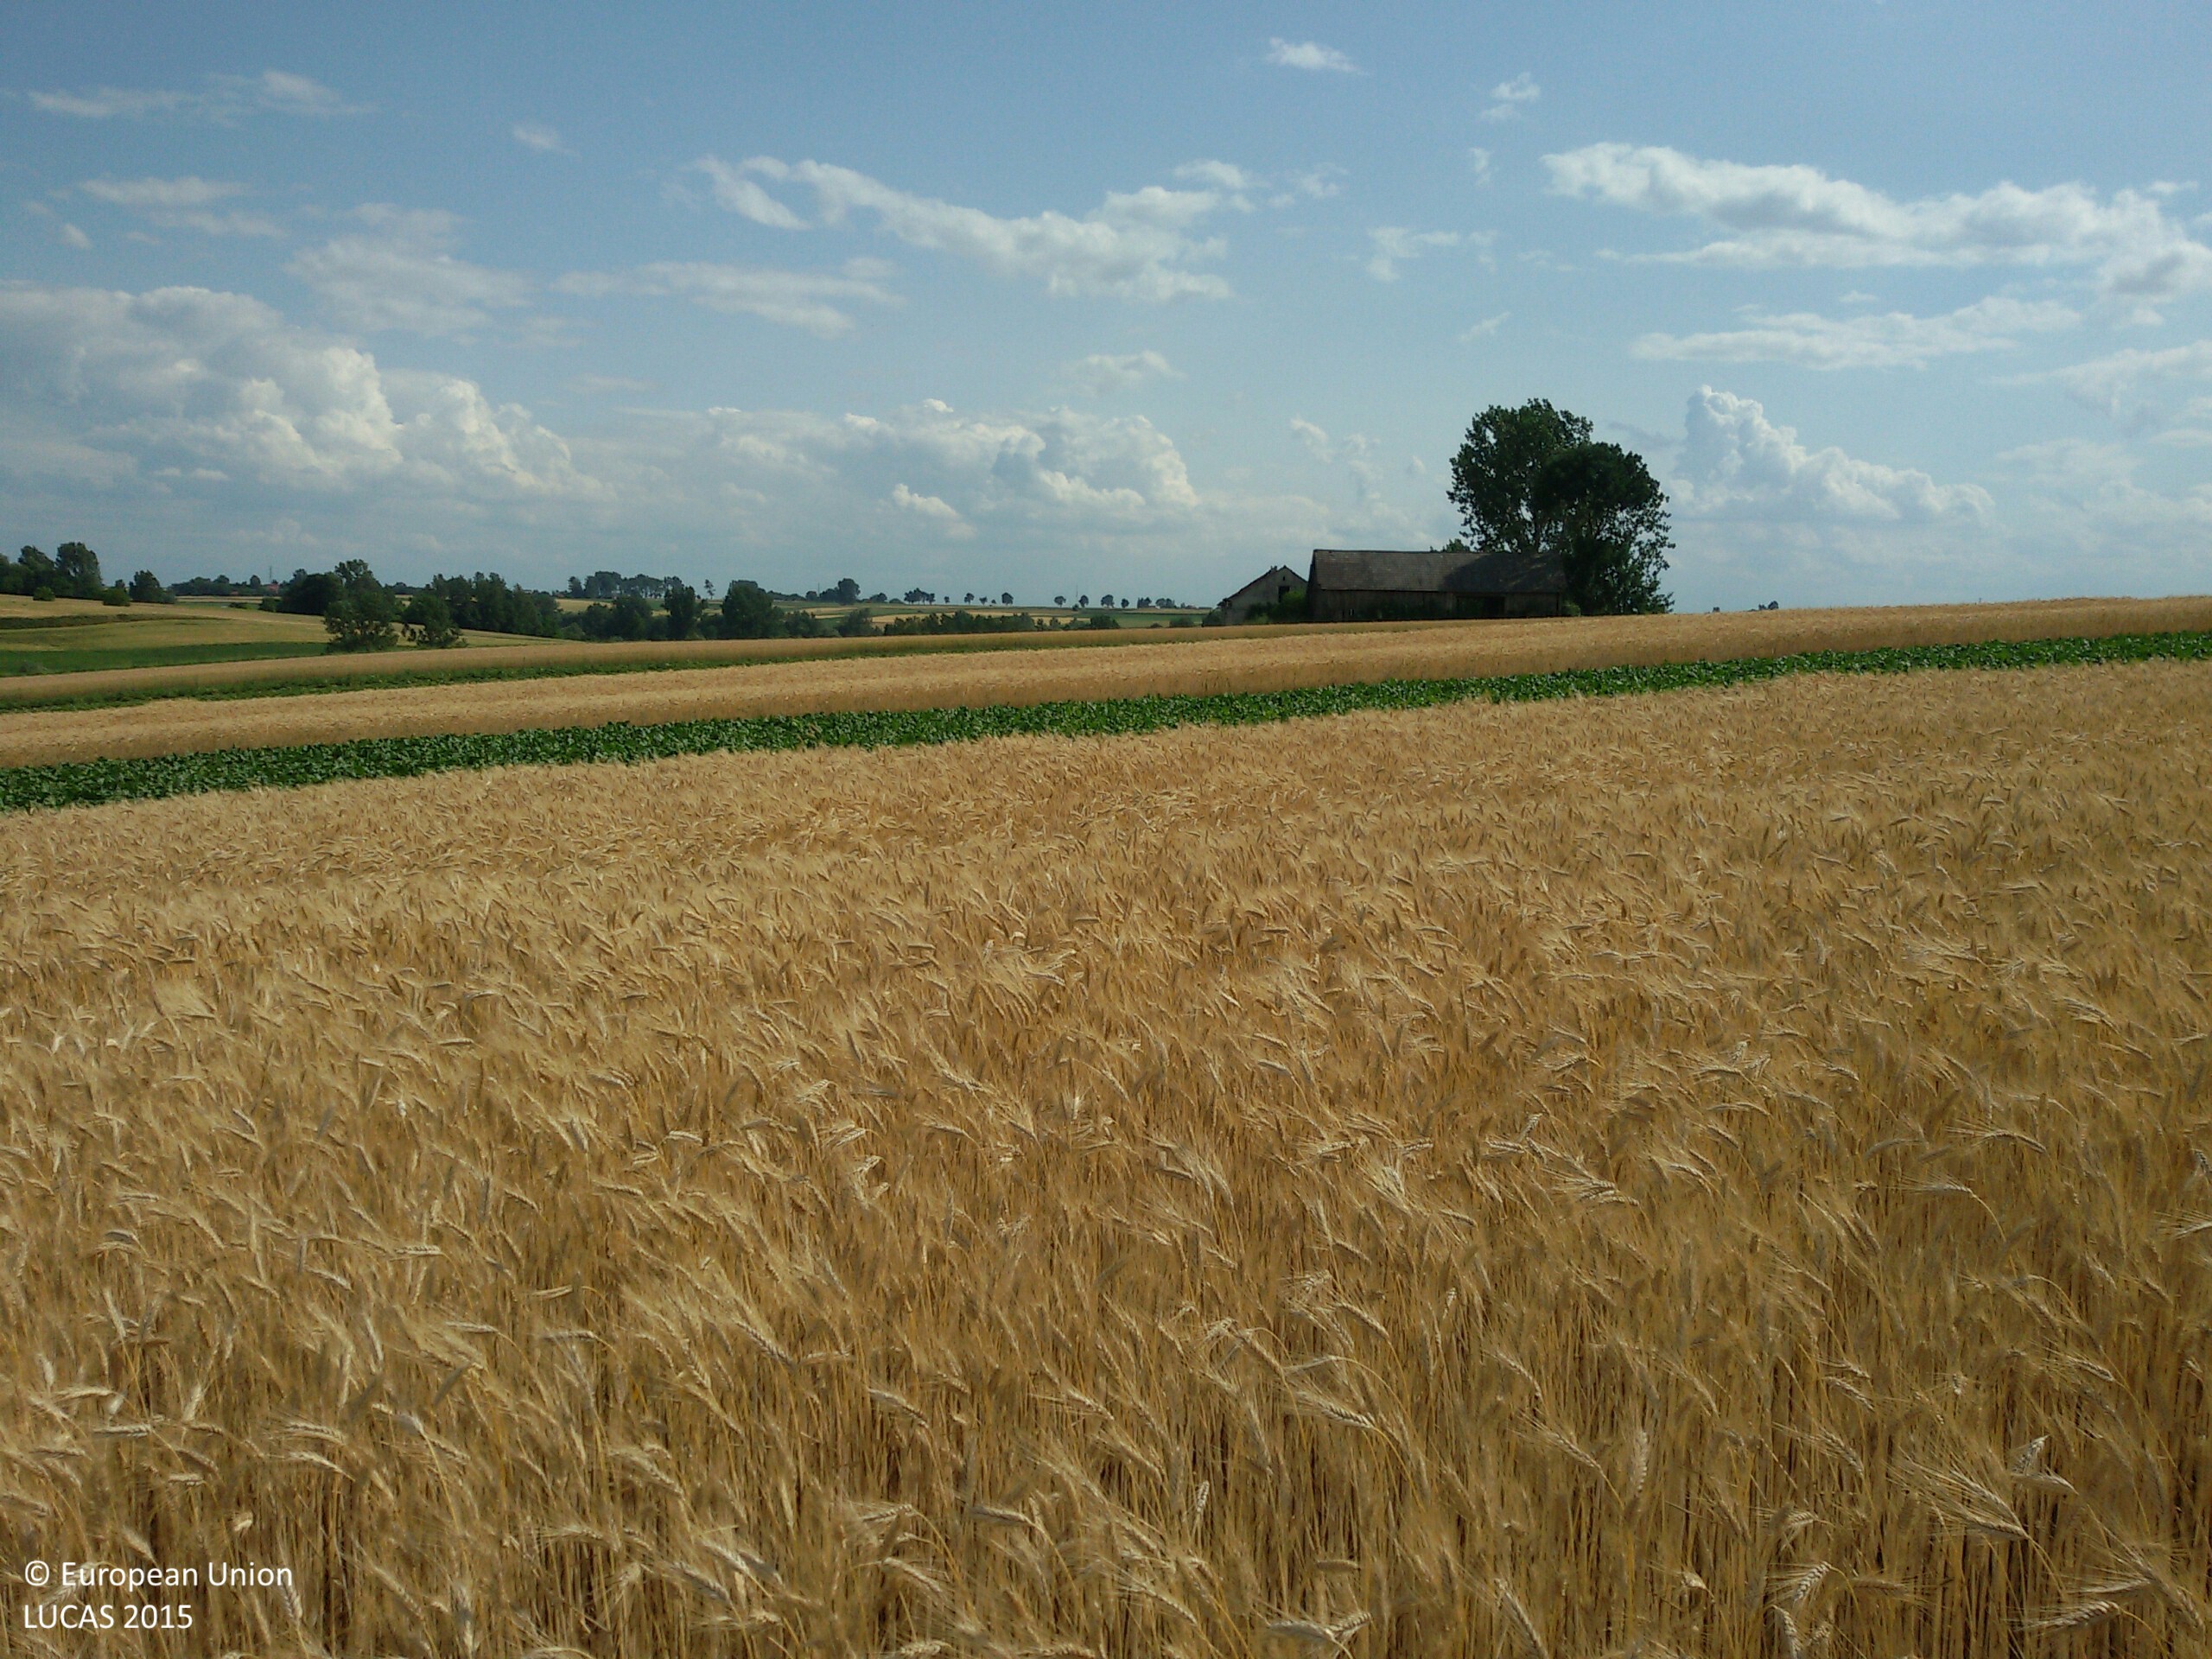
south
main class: Cropland
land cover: Triticale
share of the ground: > 75 %
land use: Agriculture (excluding fallow land and kitchen gardens)
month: July
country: PL
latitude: 50.3782
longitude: 20.4005
